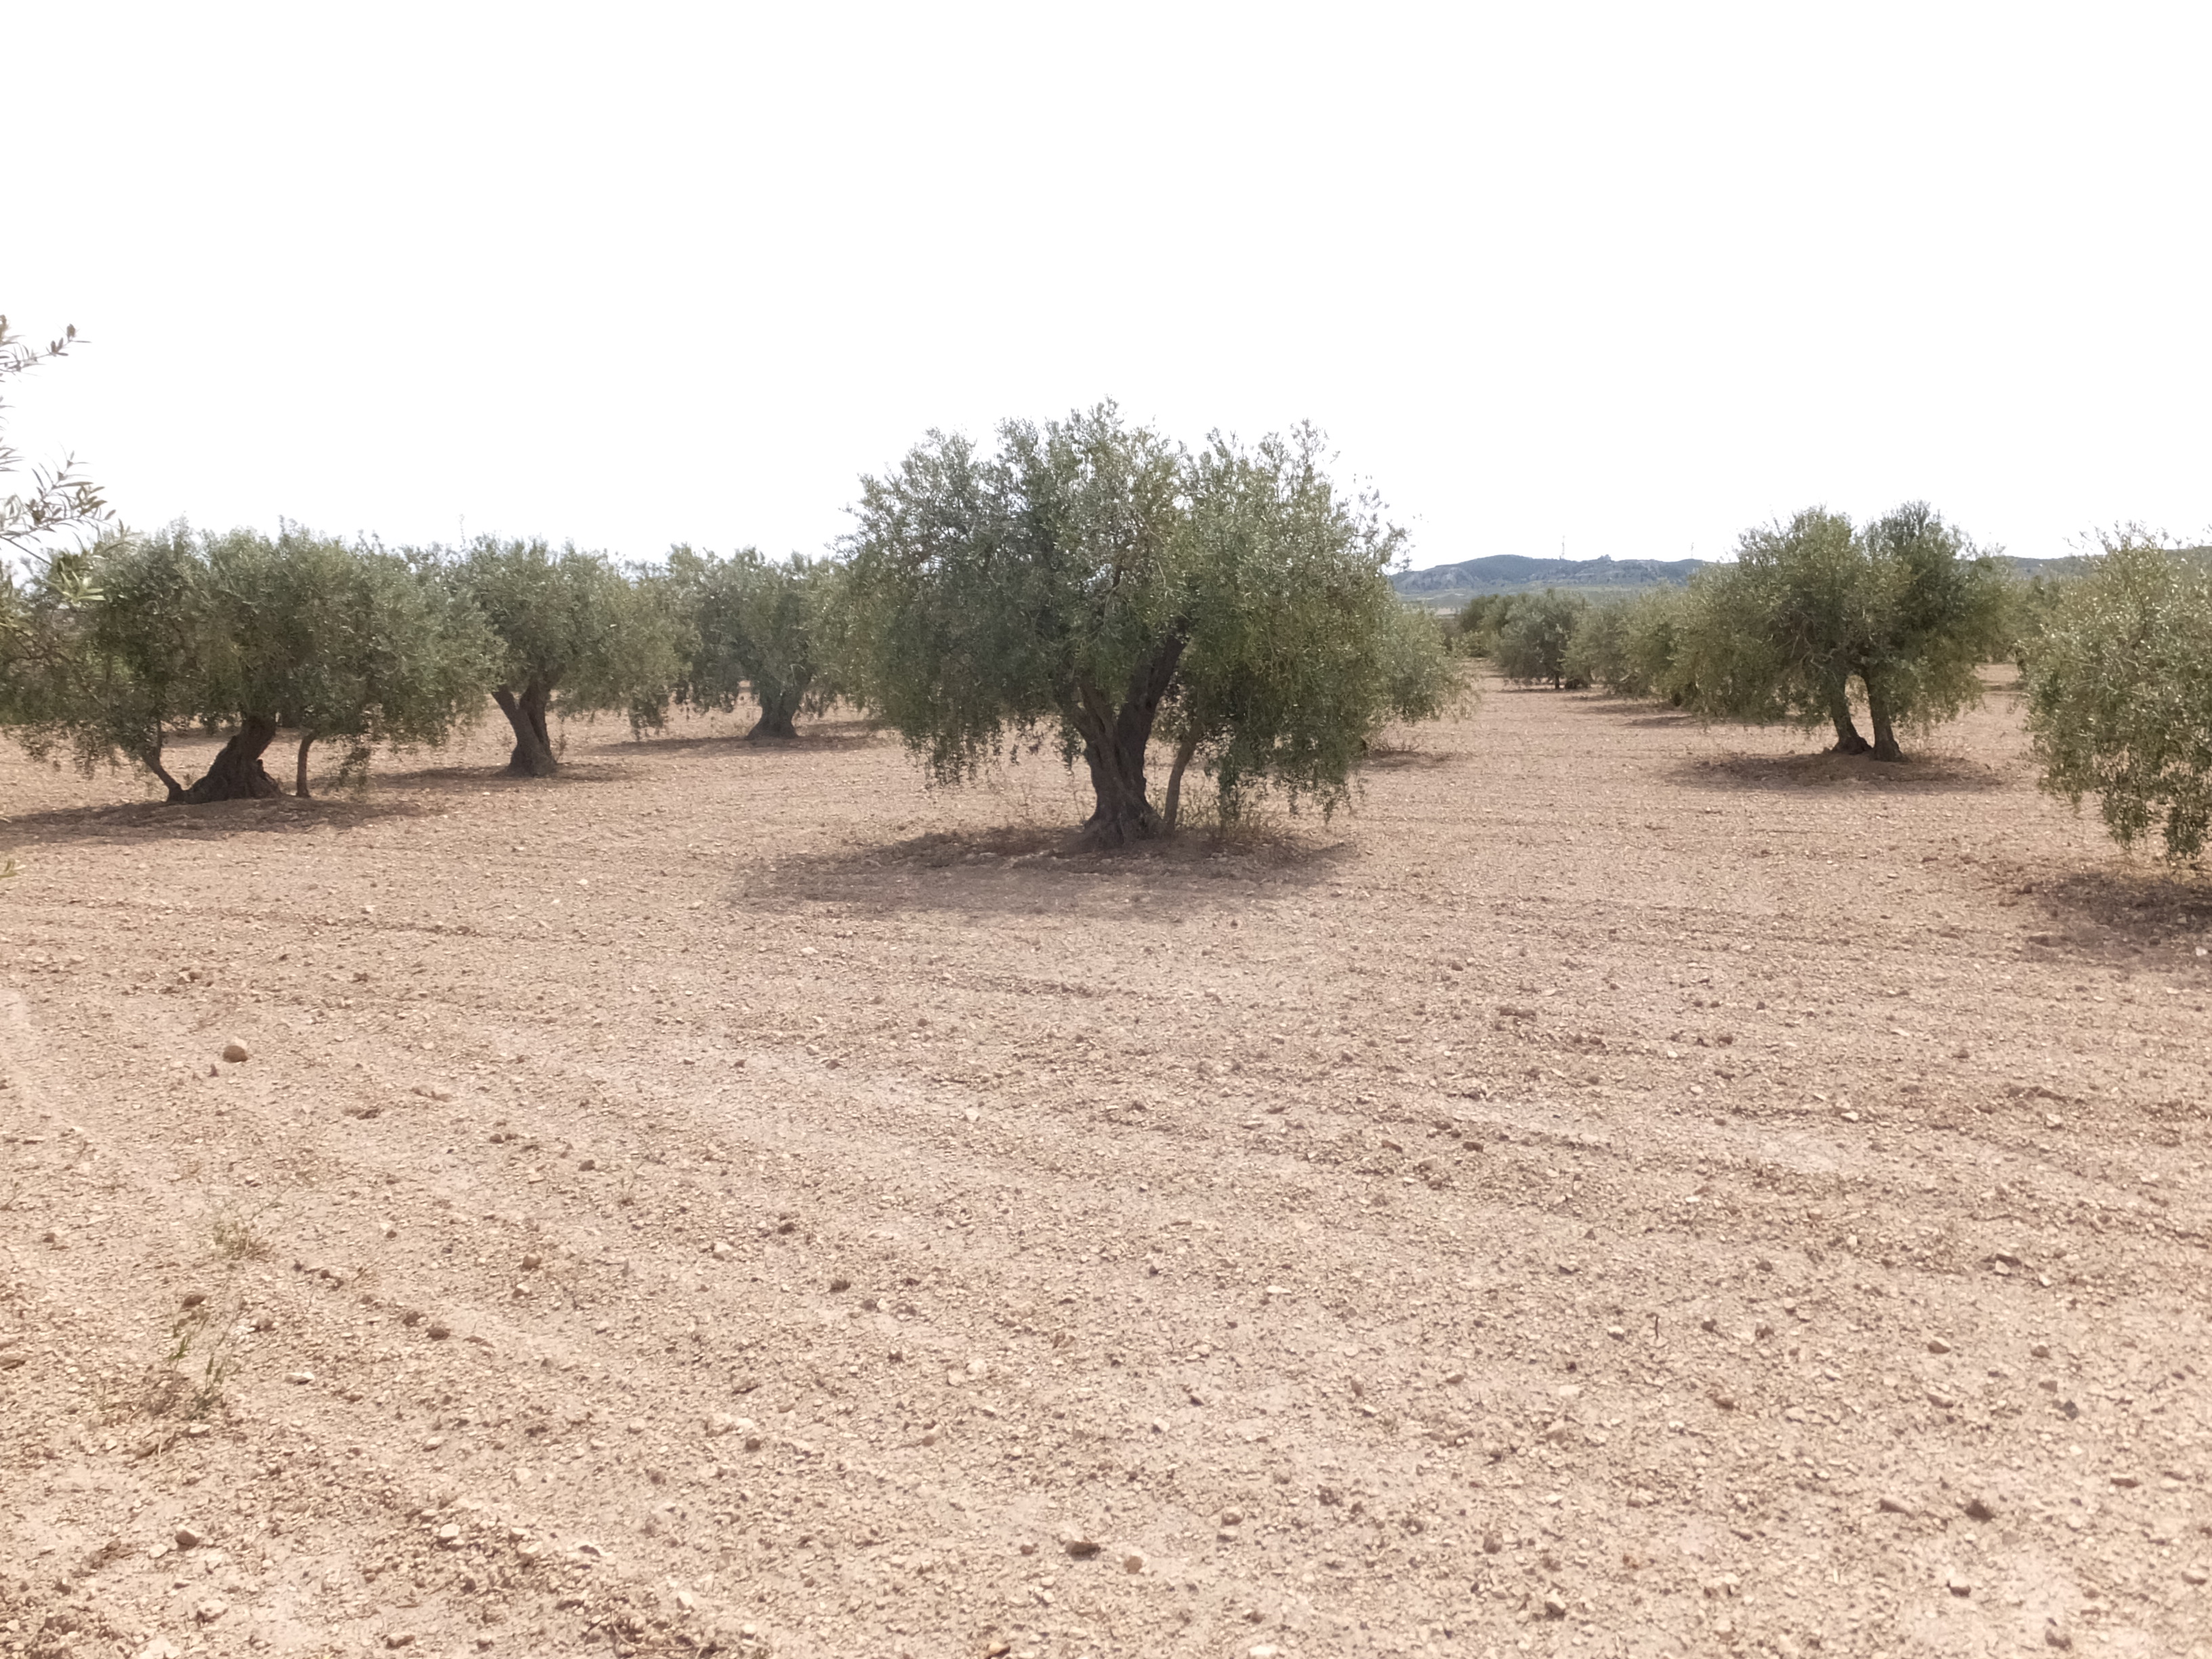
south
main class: Cropland
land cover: Olive groves
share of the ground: 10 - 25 %
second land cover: Other bare soil
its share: > 75 %
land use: Agriculture (excluding fallow land and kitchen gardens)
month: April
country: ES
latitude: 41.5918
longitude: -0.2015
